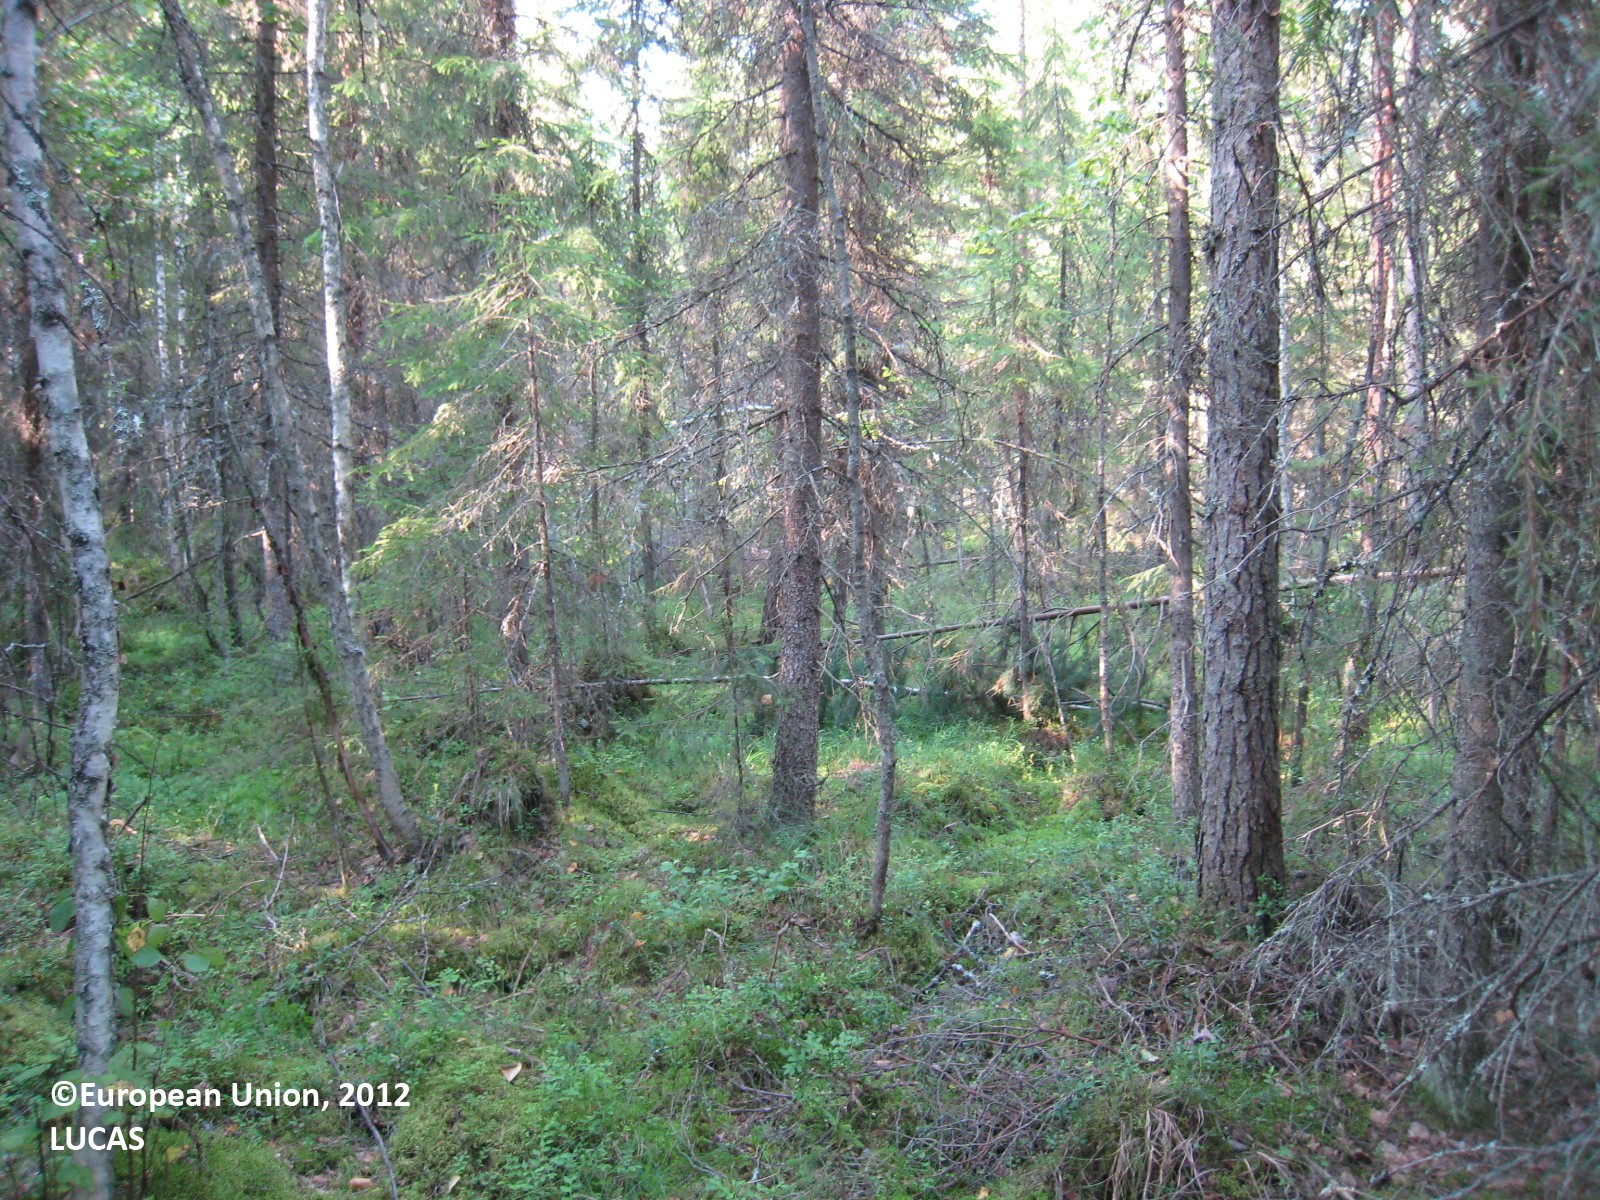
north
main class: Woodland
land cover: Other mixed woodland
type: boreal forest
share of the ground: > 75 %
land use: Forestry
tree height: > 5 m
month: July
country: FI
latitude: 62.6154
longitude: 27.3295
